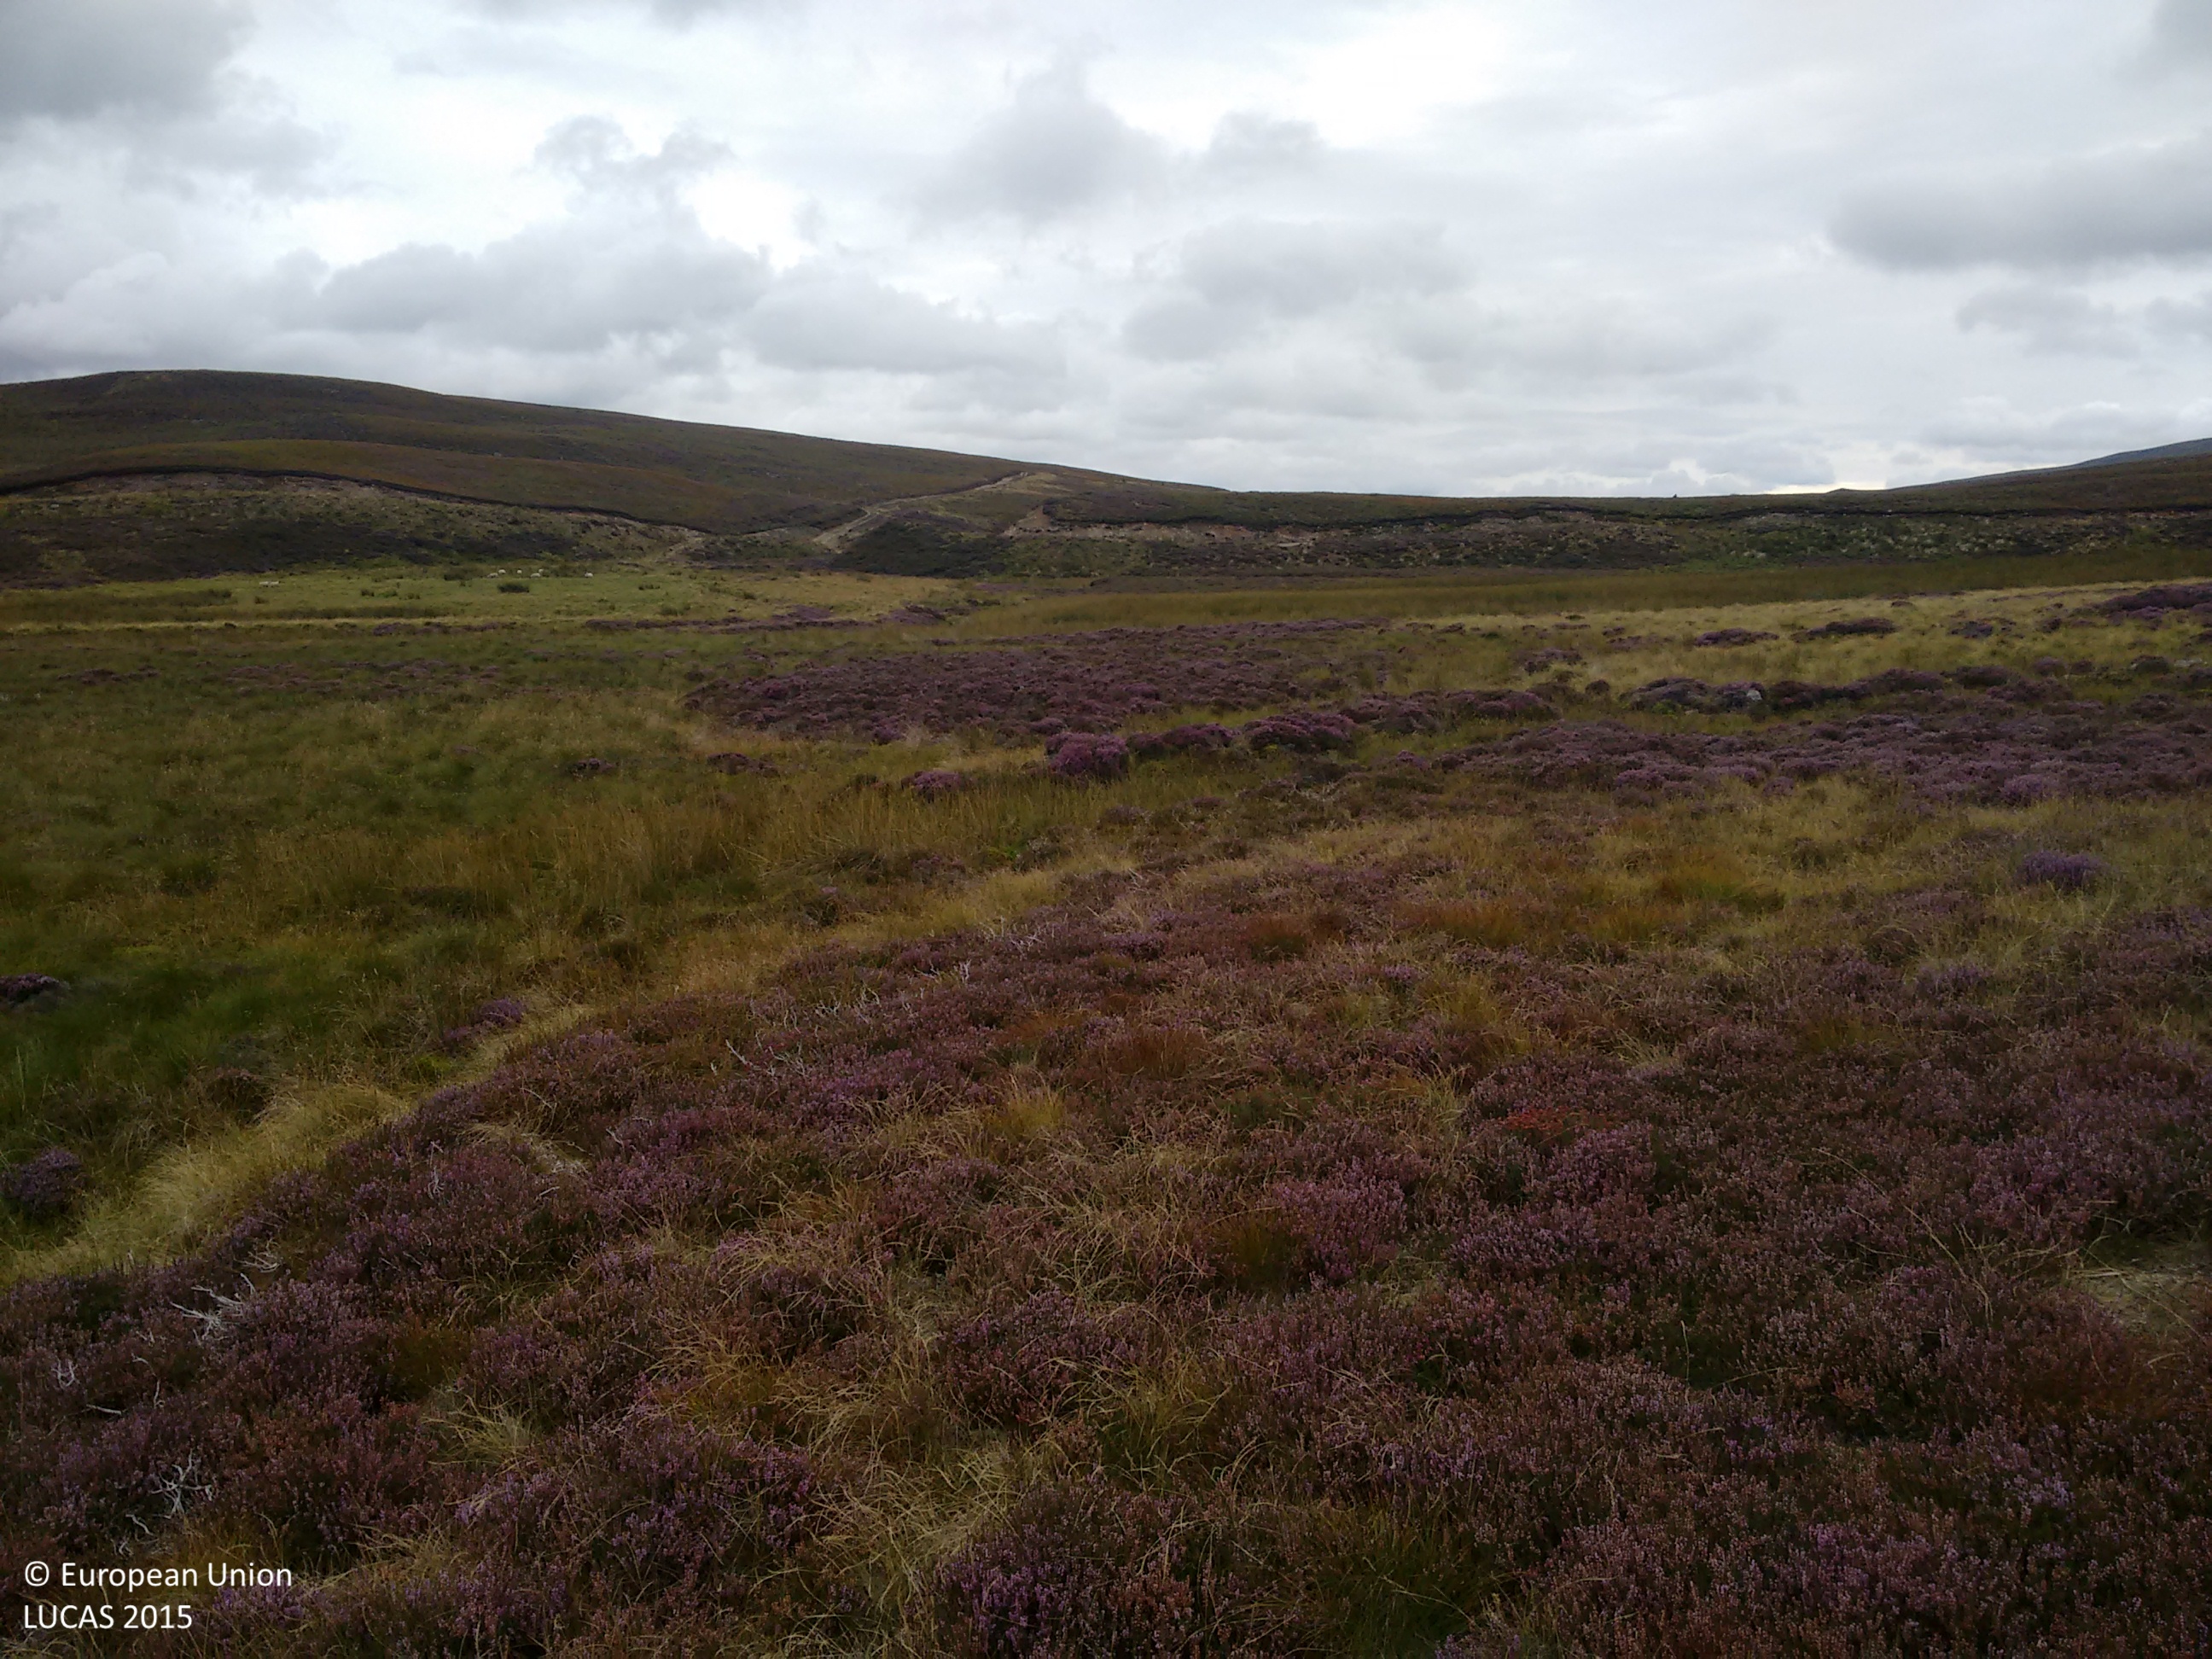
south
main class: Shrubland
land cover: Shrubland without tree cover
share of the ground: > 75 %
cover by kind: shrubs 80 %, herbaceous plants 20 %
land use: Agriculture (excluding fallow land and kitchen gardens)
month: September
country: GB
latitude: 57.4562
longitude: -3.8955
